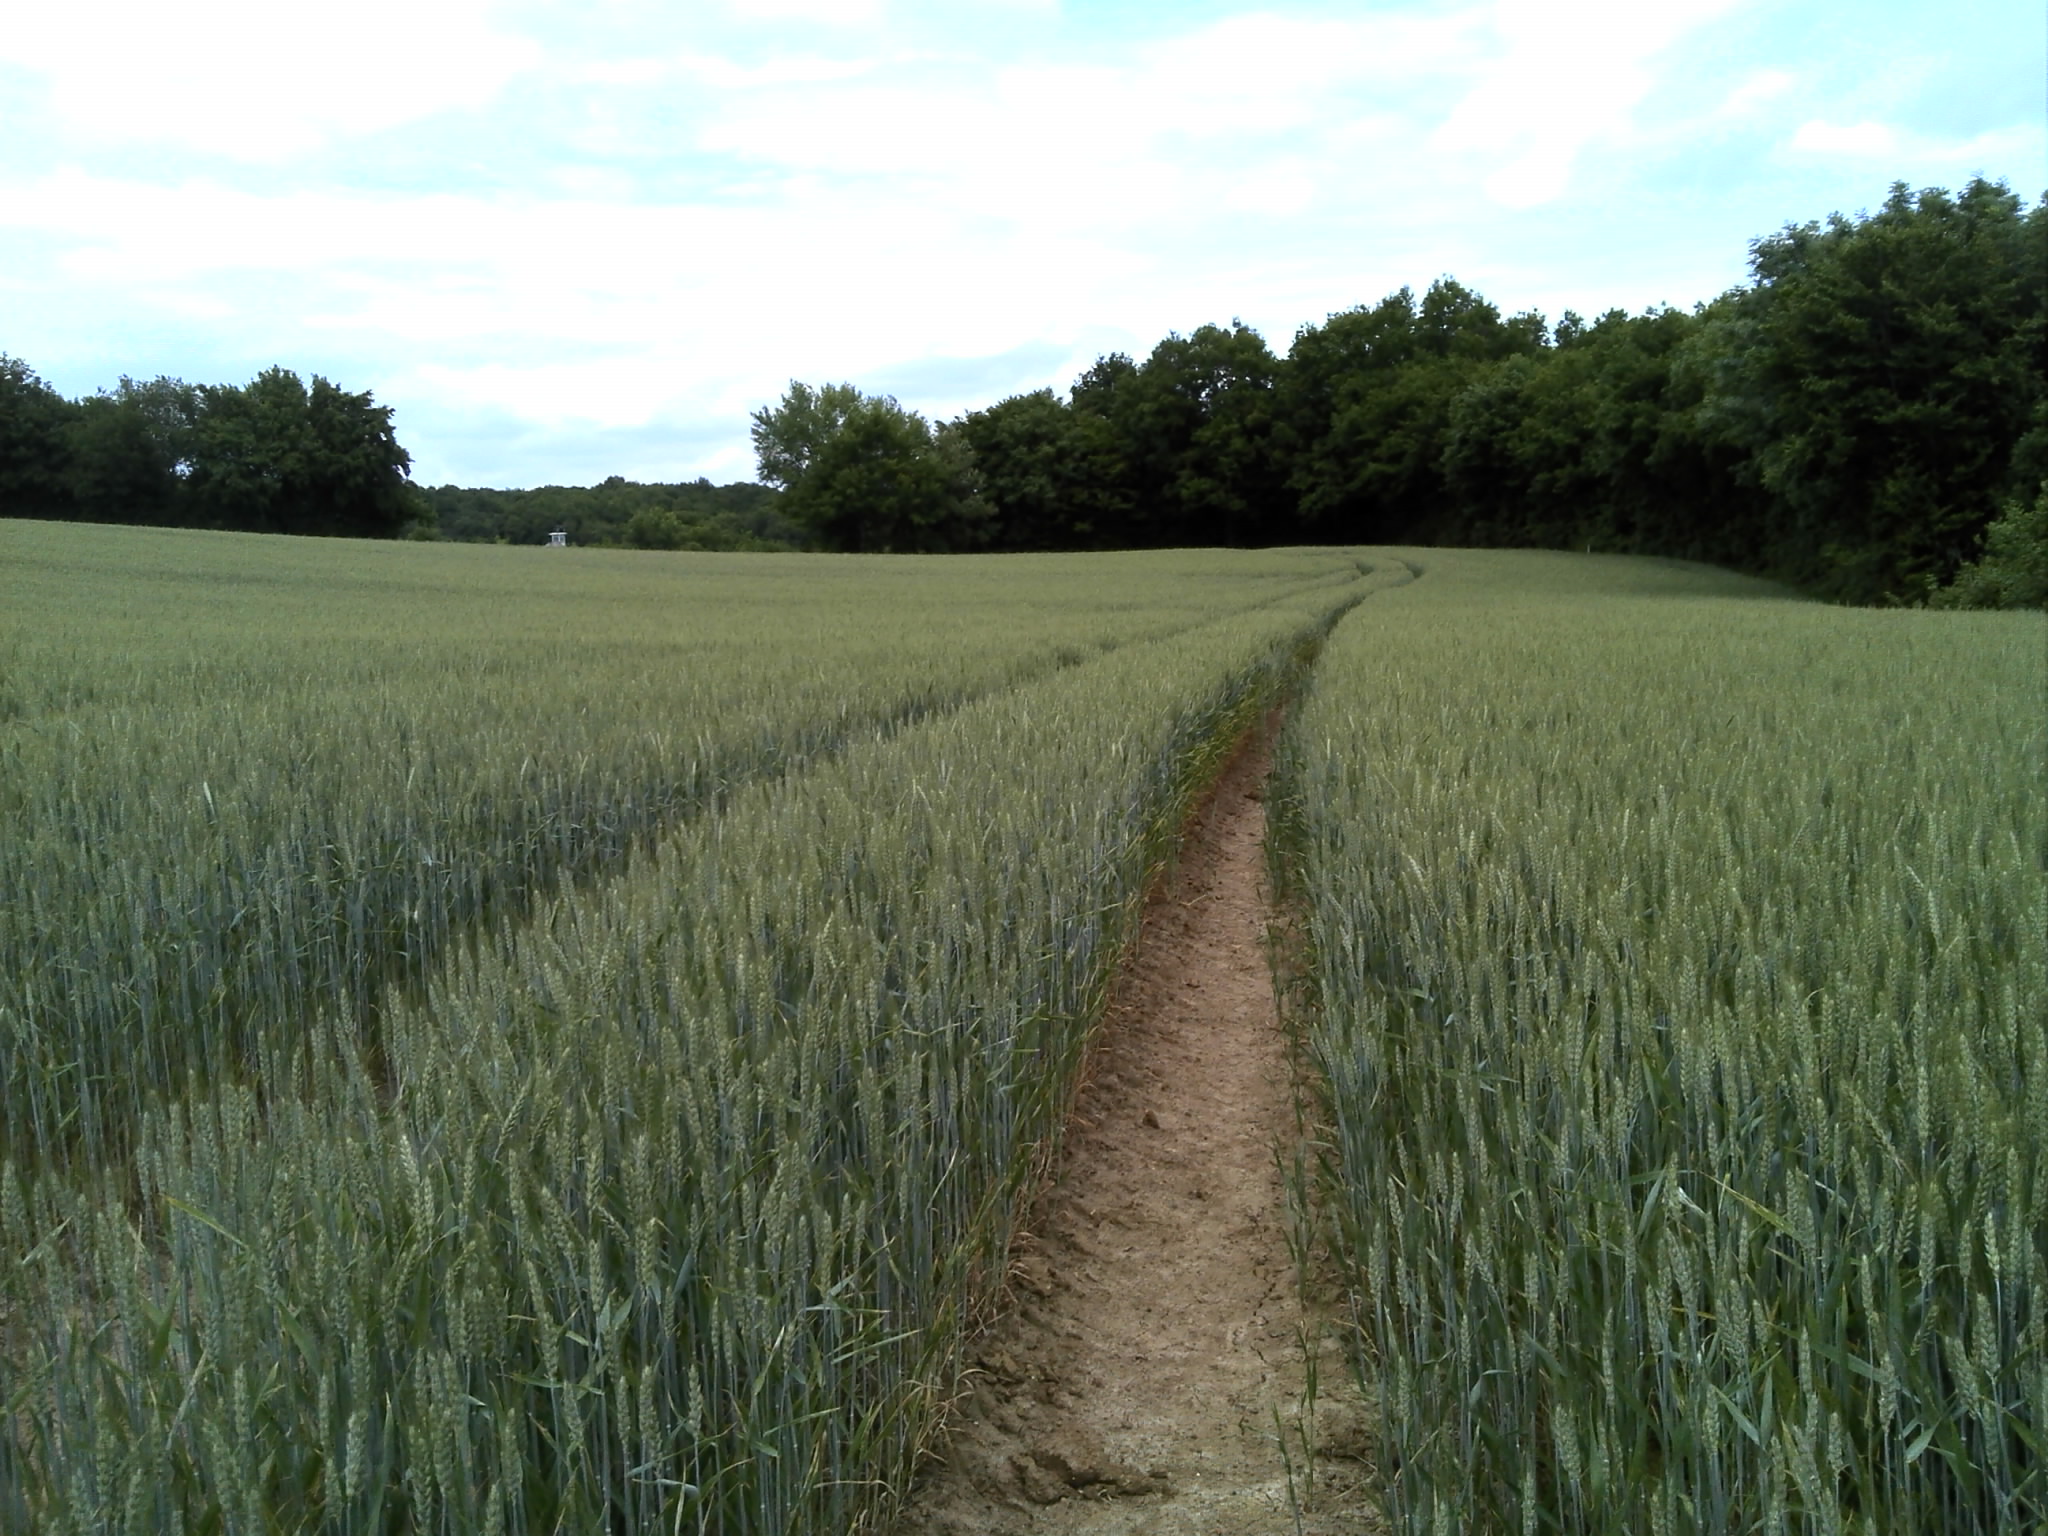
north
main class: Cropland
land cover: Common wheat
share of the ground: > 75 %
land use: Agriculture (excluding fallow land and kitchen gardens)
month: May
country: FR
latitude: 46.5912
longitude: 1.4924
